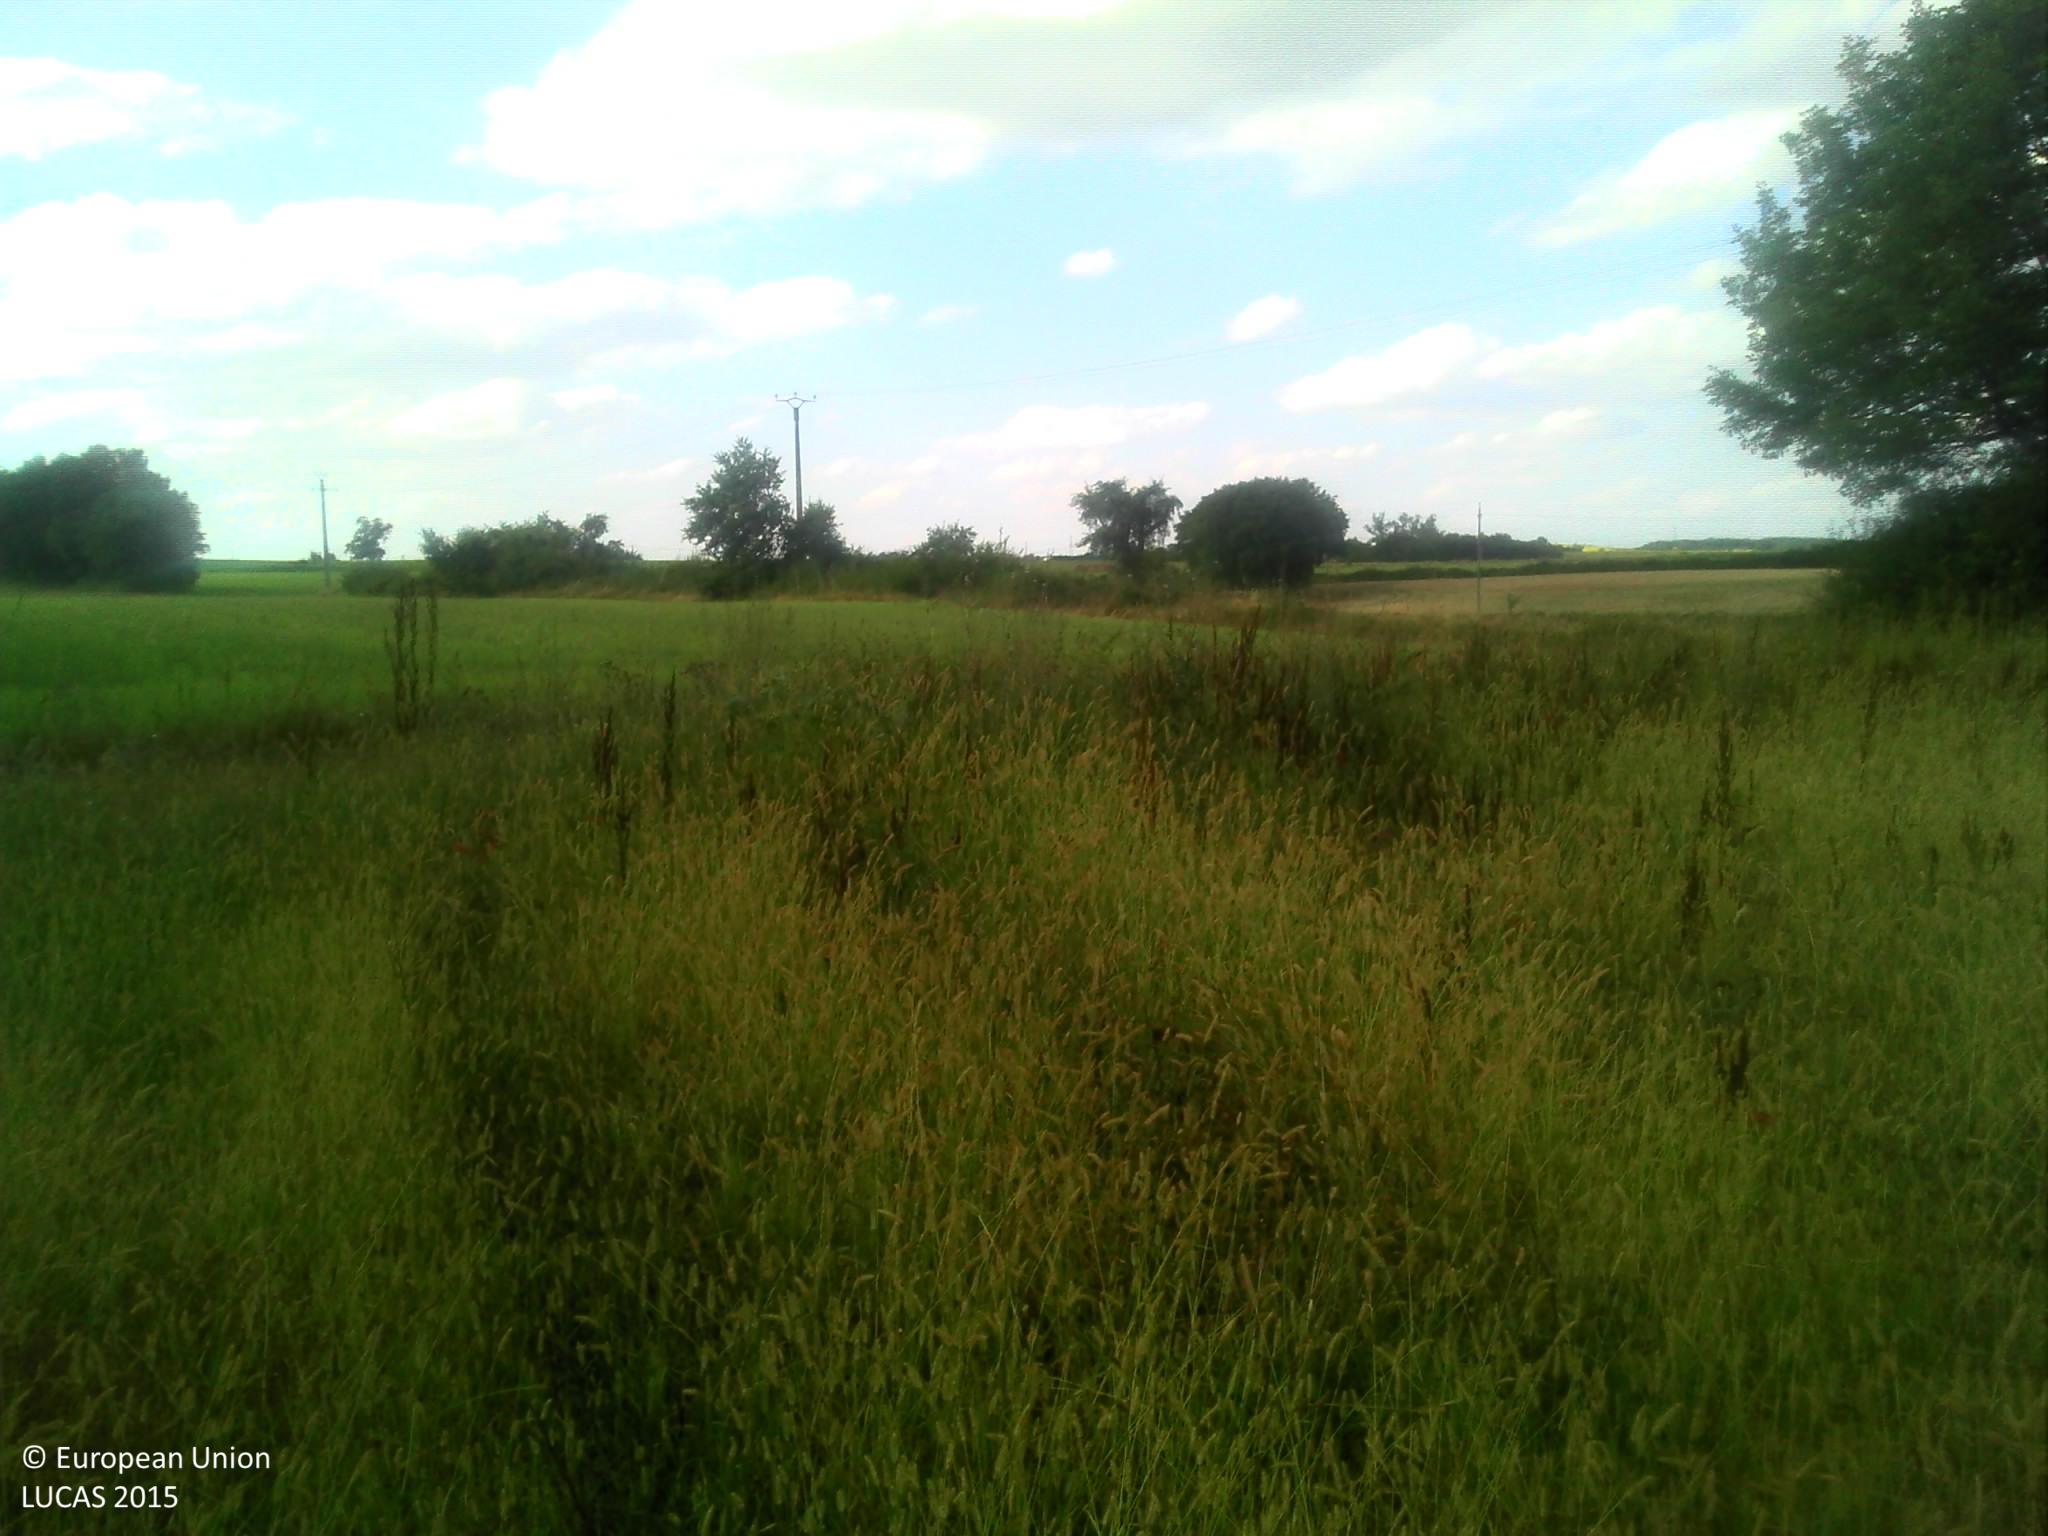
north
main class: Grassland
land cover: Spontaneously vegetated surfaces
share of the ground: > 75 %
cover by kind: herbaceous plants 100 %
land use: Fallow land
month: July
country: FR
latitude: 44.0521
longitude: 0.6217
